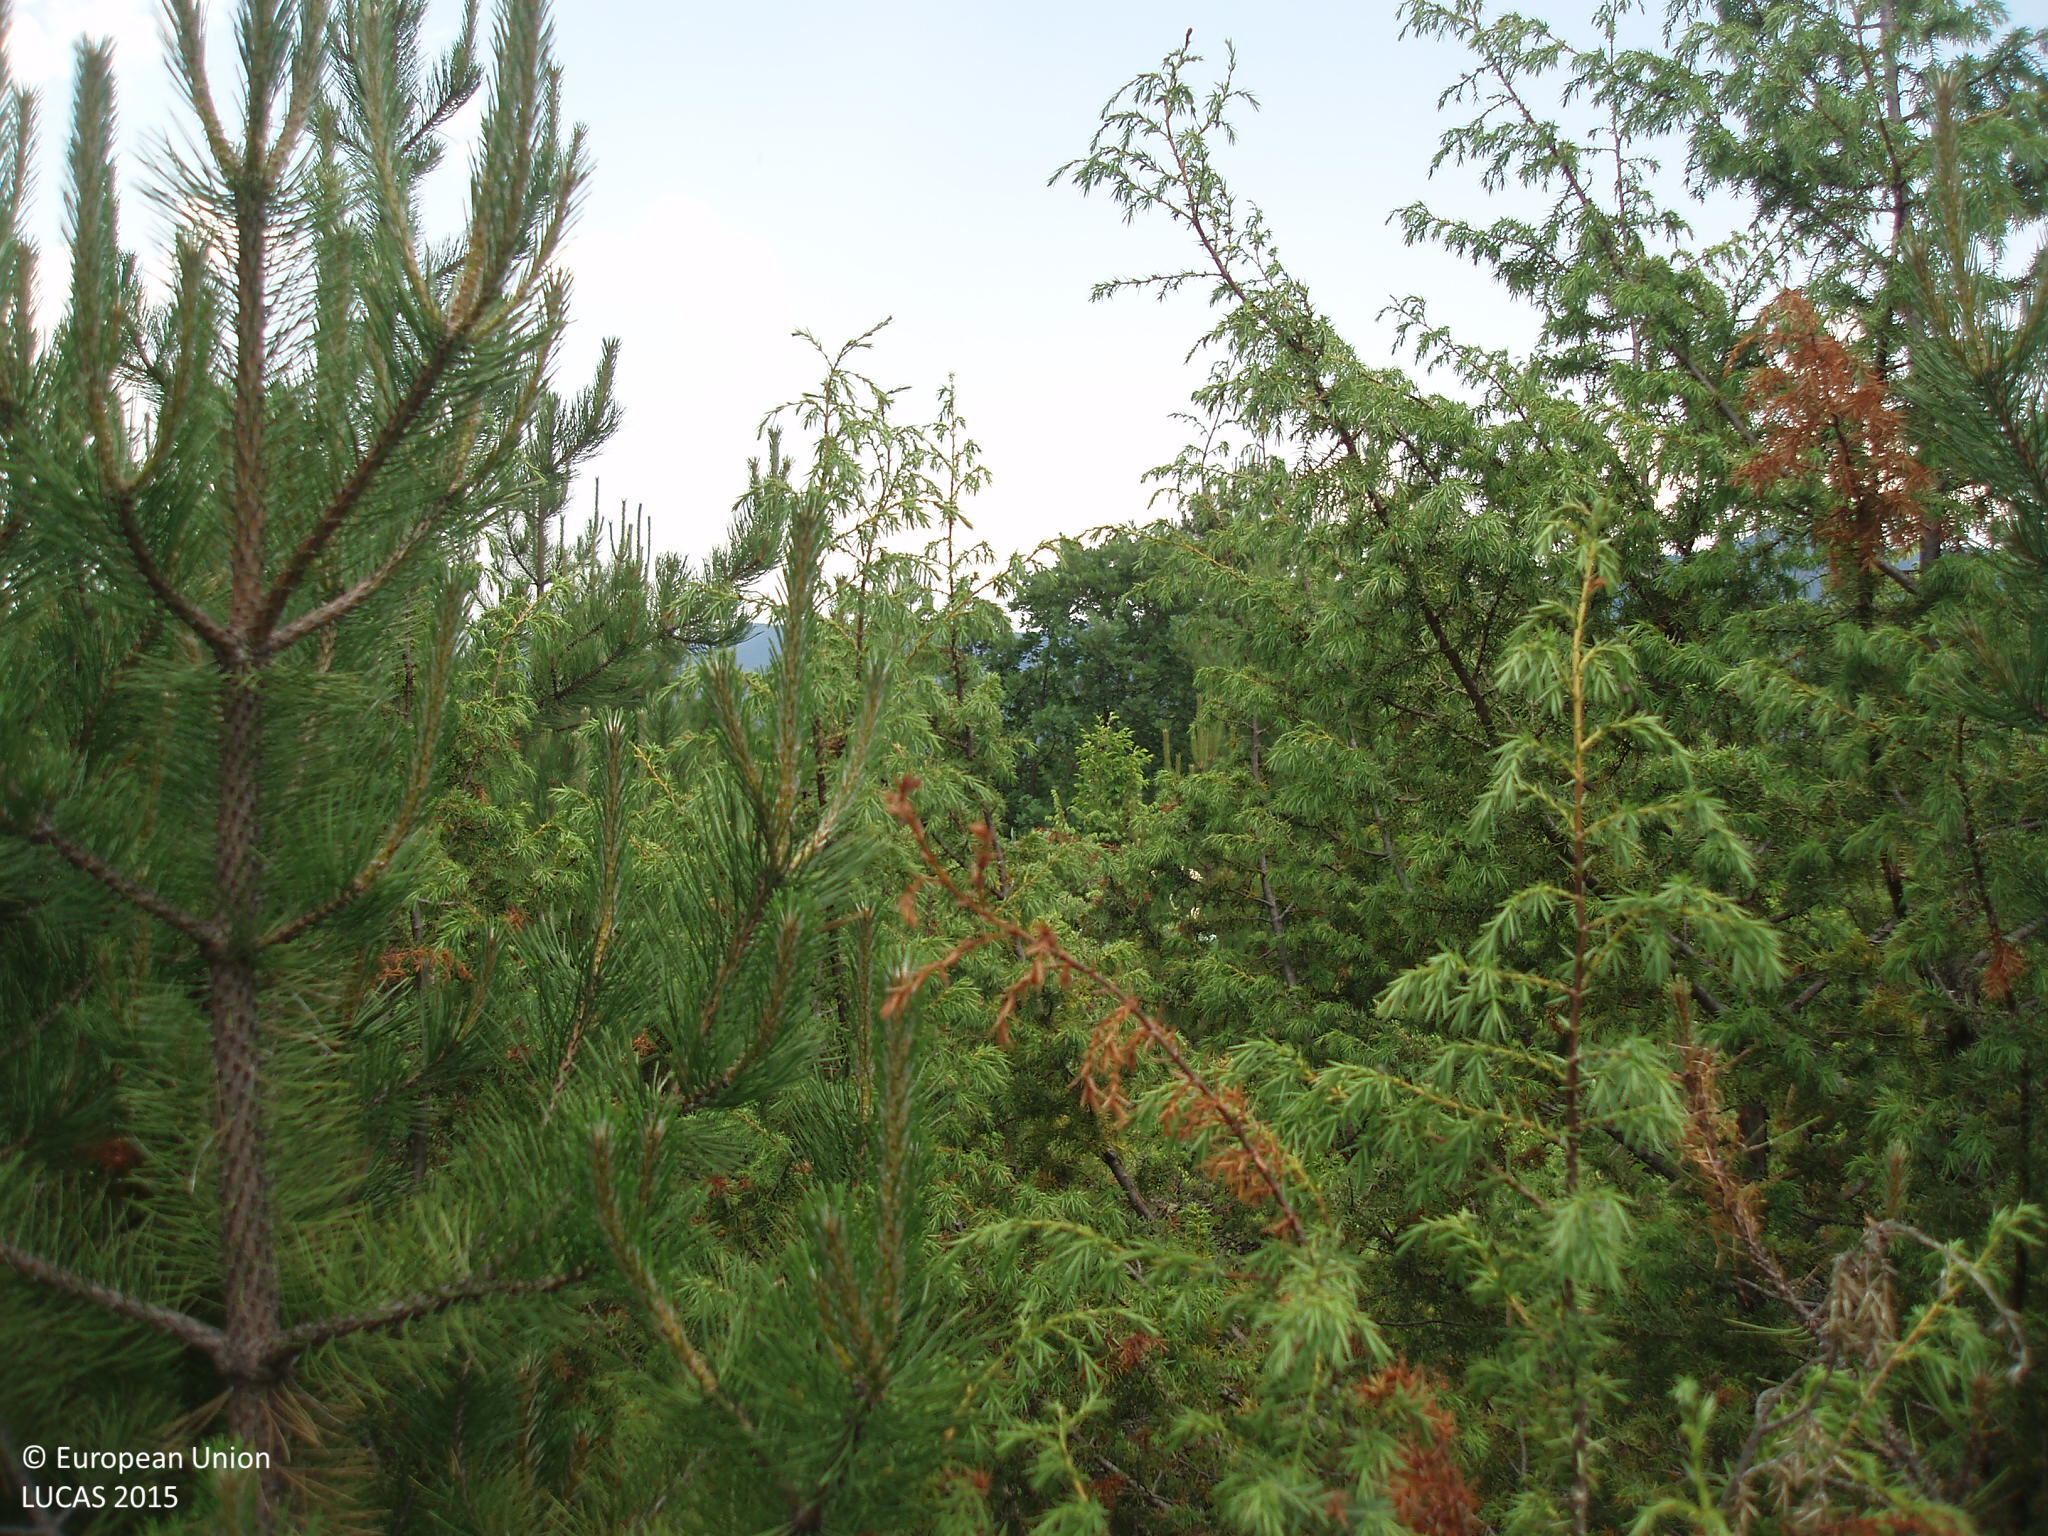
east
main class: Woodland
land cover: Other mixed woodland
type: hemiboreal forest and nemoral coniferous forest and mixed broadleaved-coniferous forest
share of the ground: > 75 %
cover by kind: coniferous forest trees 75 %, broadleaved forest trees 25 %
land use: Forestry
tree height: > 5 m
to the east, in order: Other mixed woodland; Tracks; Other mixed woodland
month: June
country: BG
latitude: 41.4073
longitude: 23.6989
